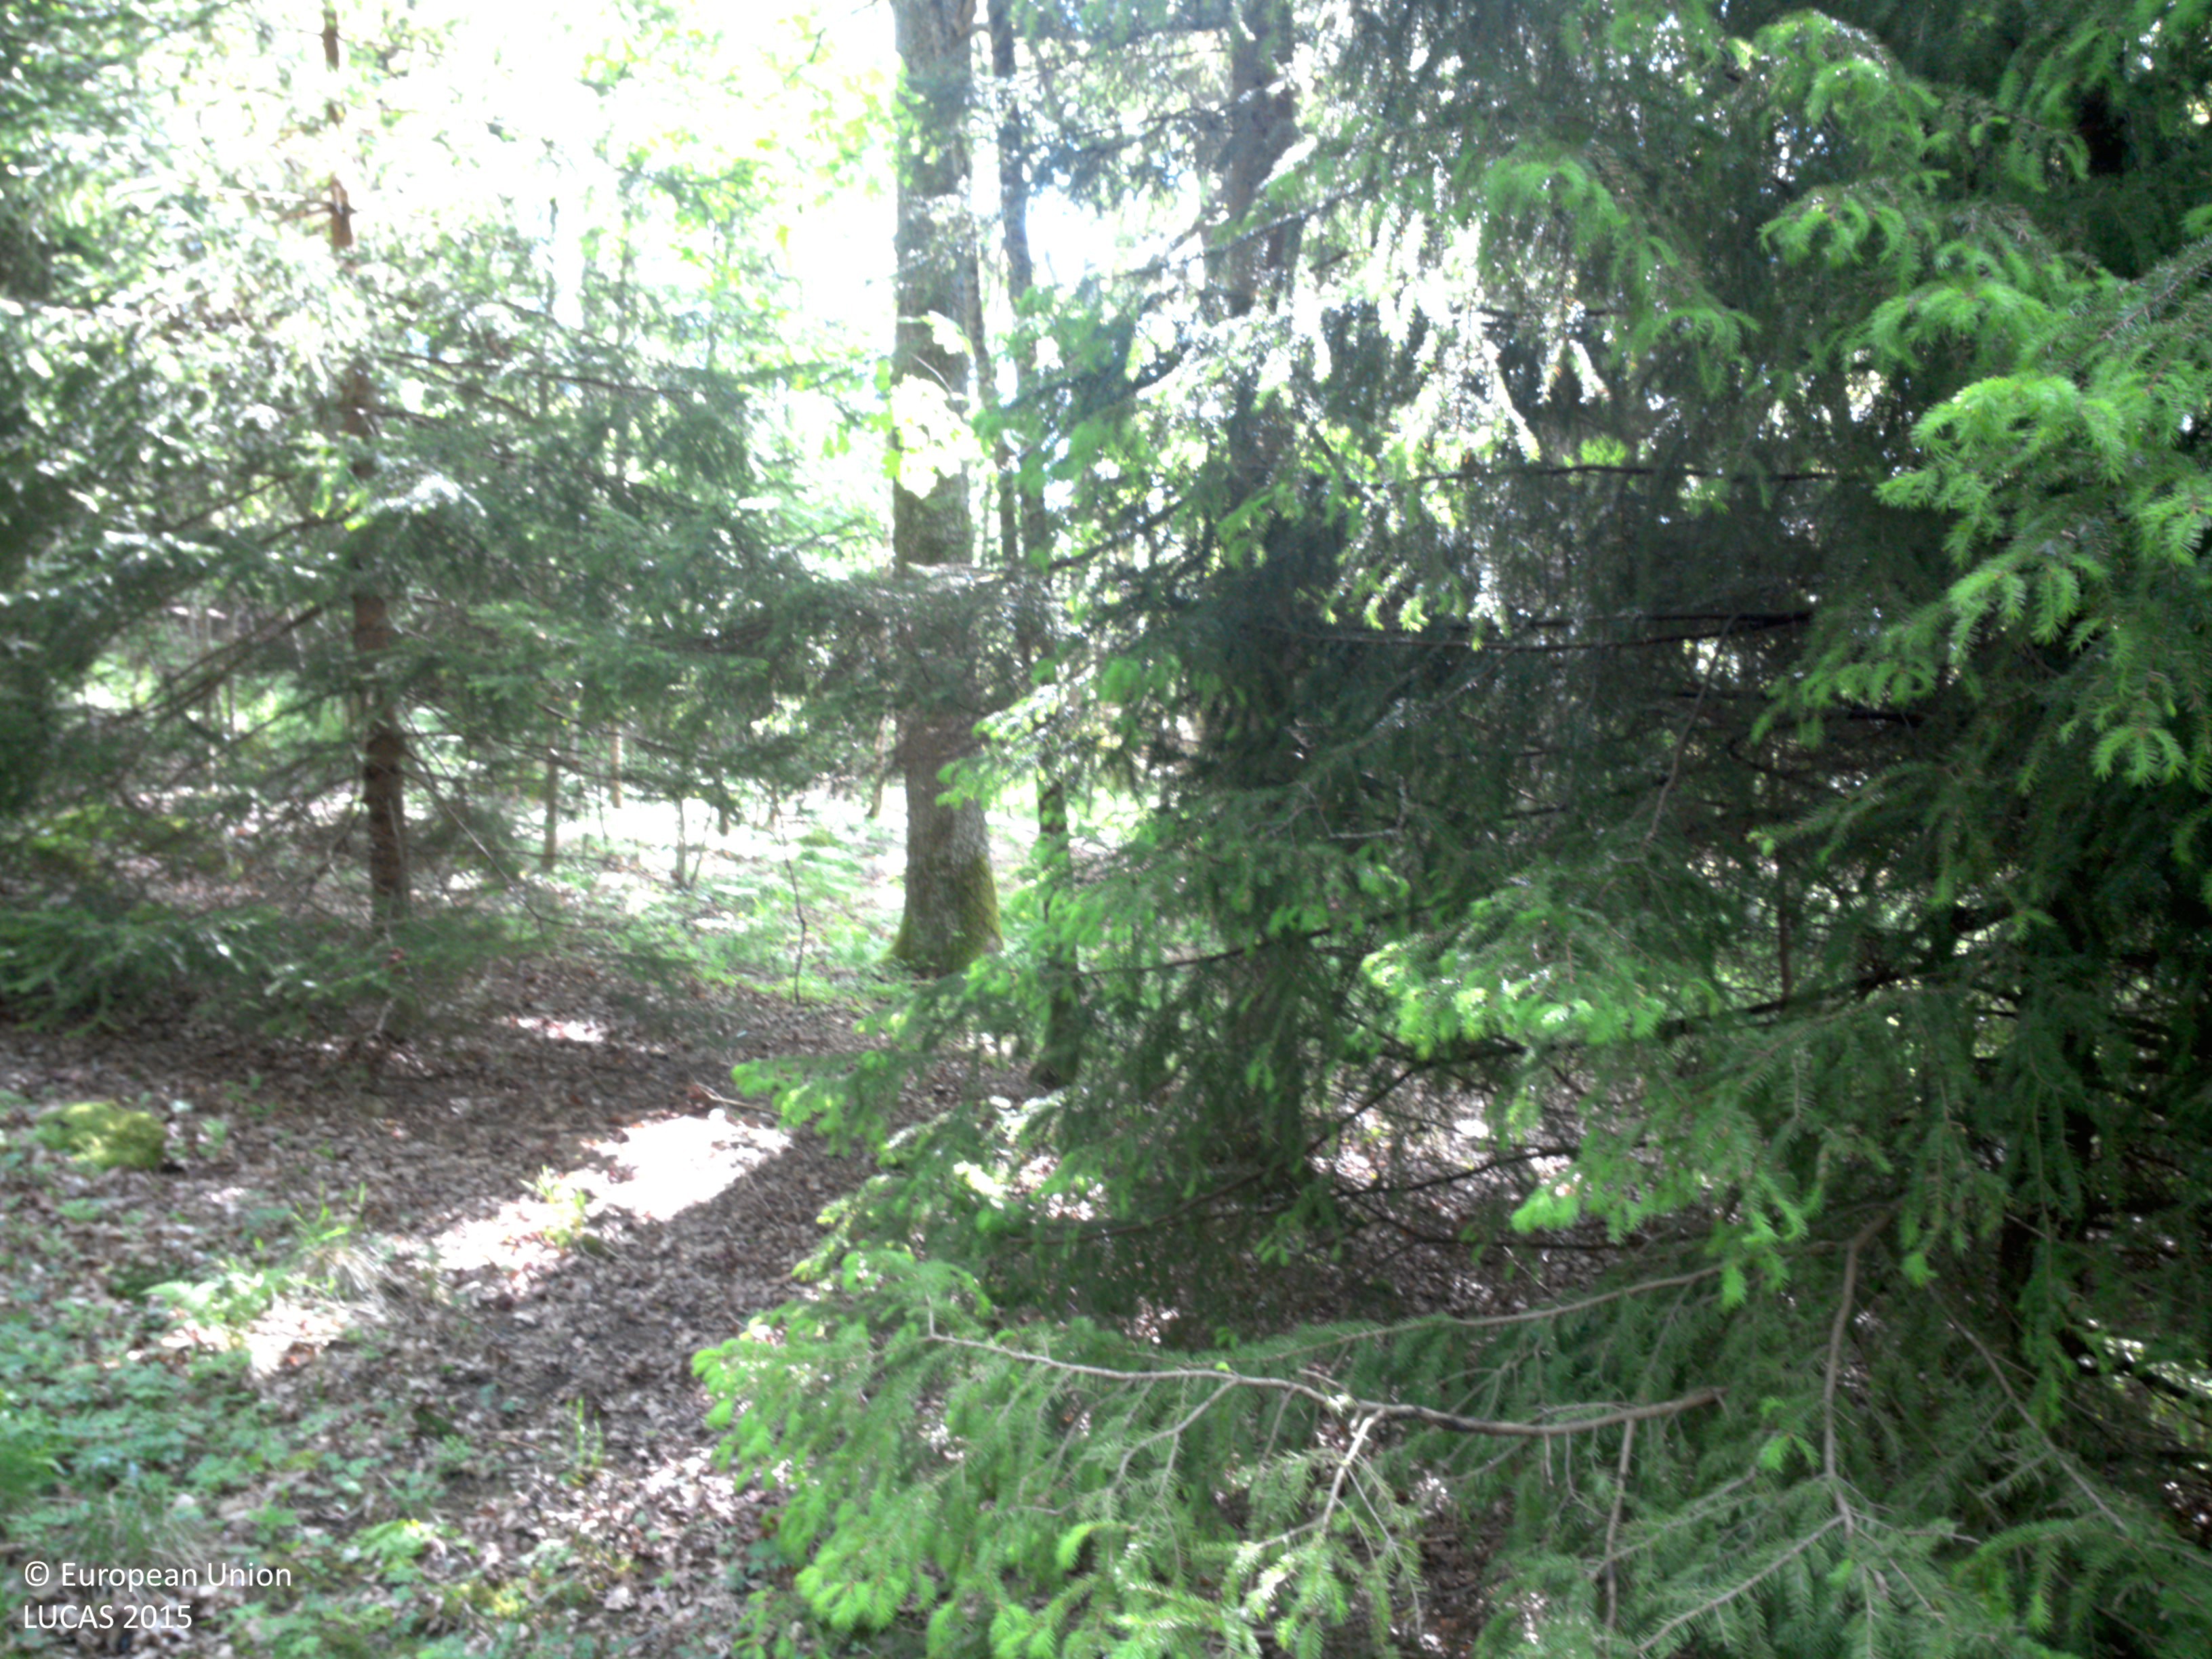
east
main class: Woodland
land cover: Broadleaved woodland
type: mesophytic deciduous forest
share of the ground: 50 - 75 %
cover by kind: broadleaved forest trees 65 %, herbaceous plants 30 %, coniferous forest trees 5 %
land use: Forestry
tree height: > 5 m
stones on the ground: 10 - 25 %
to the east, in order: Broadleaved woodland; Dry stone walls; Broadleaved woodland; Grassland without tree/shrub cover; Dry stone walls; Shrubland with sparse tree cover
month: June
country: SE
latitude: 58.3506
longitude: 11.8587
